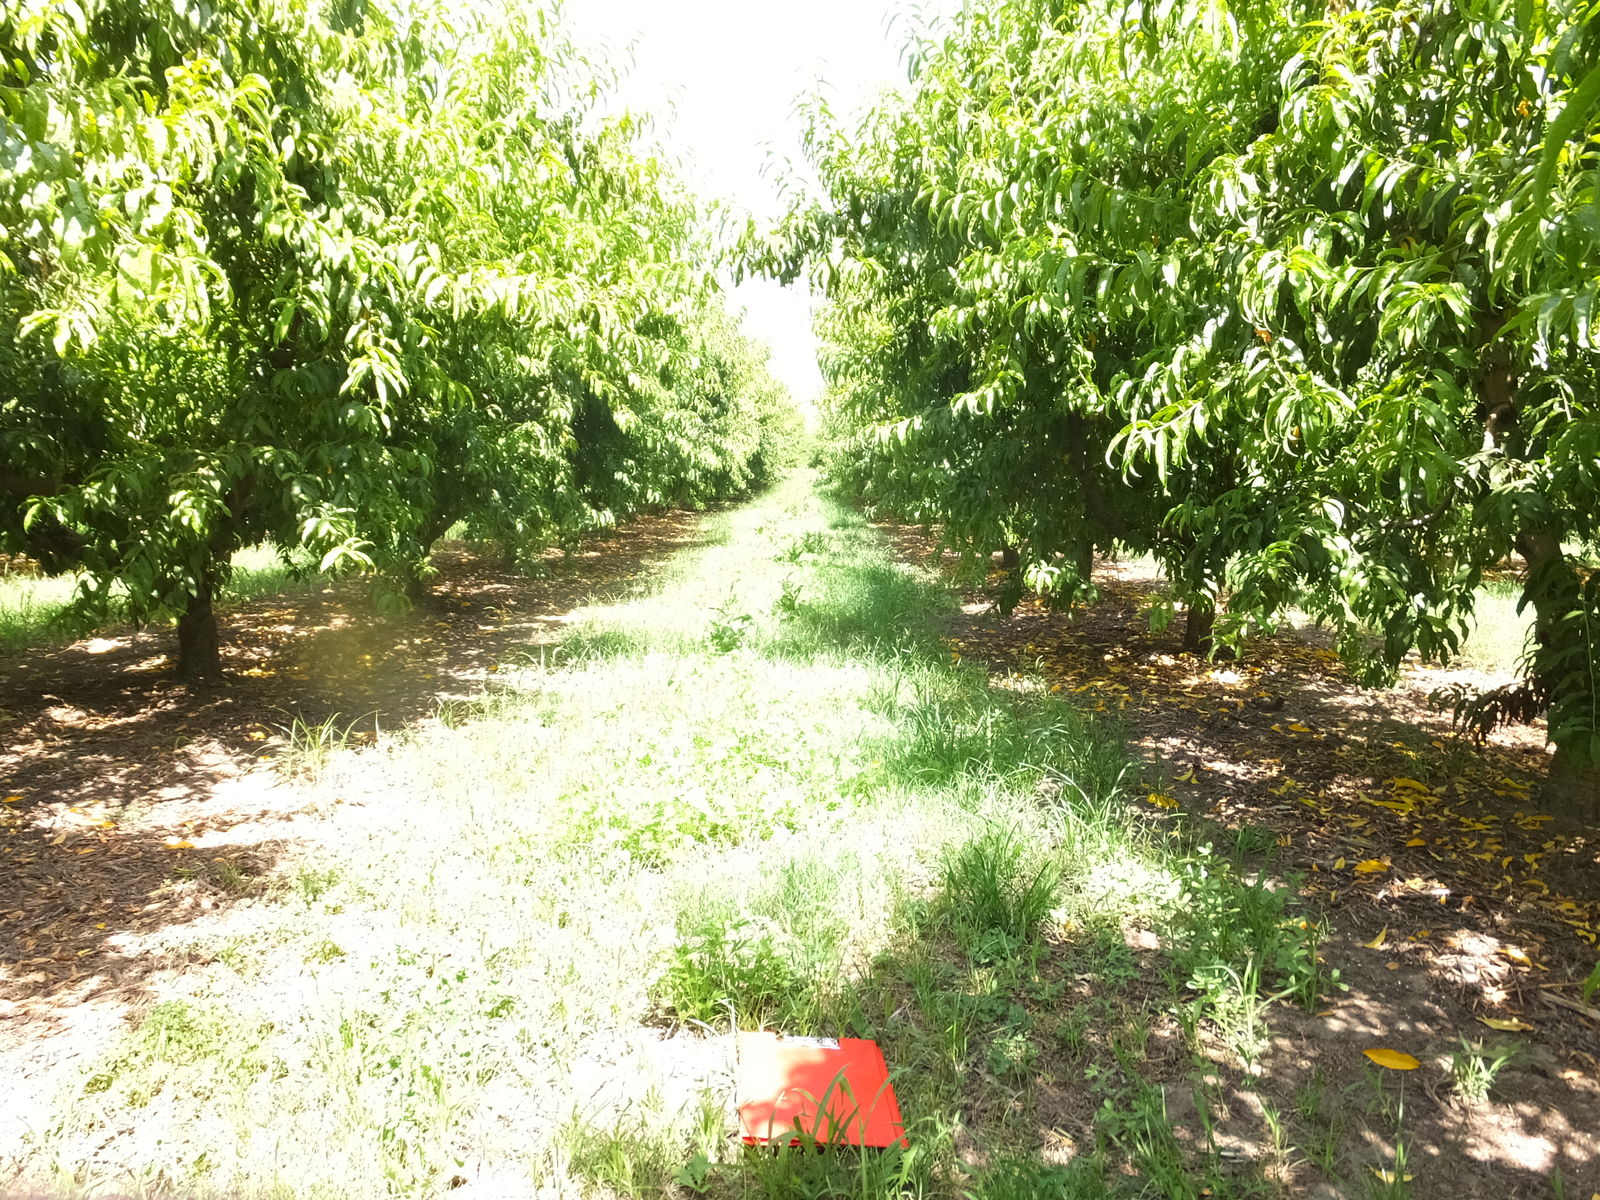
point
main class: Cropland
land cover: Other fruit trees and berries
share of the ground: > 75 %
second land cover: Spontaneously vegetated surfaces
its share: 10 - 25 %
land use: Agriculture (excluding fallow land and kitchen gardens)
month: July
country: ES
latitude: 41.5145
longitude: 0.4860
